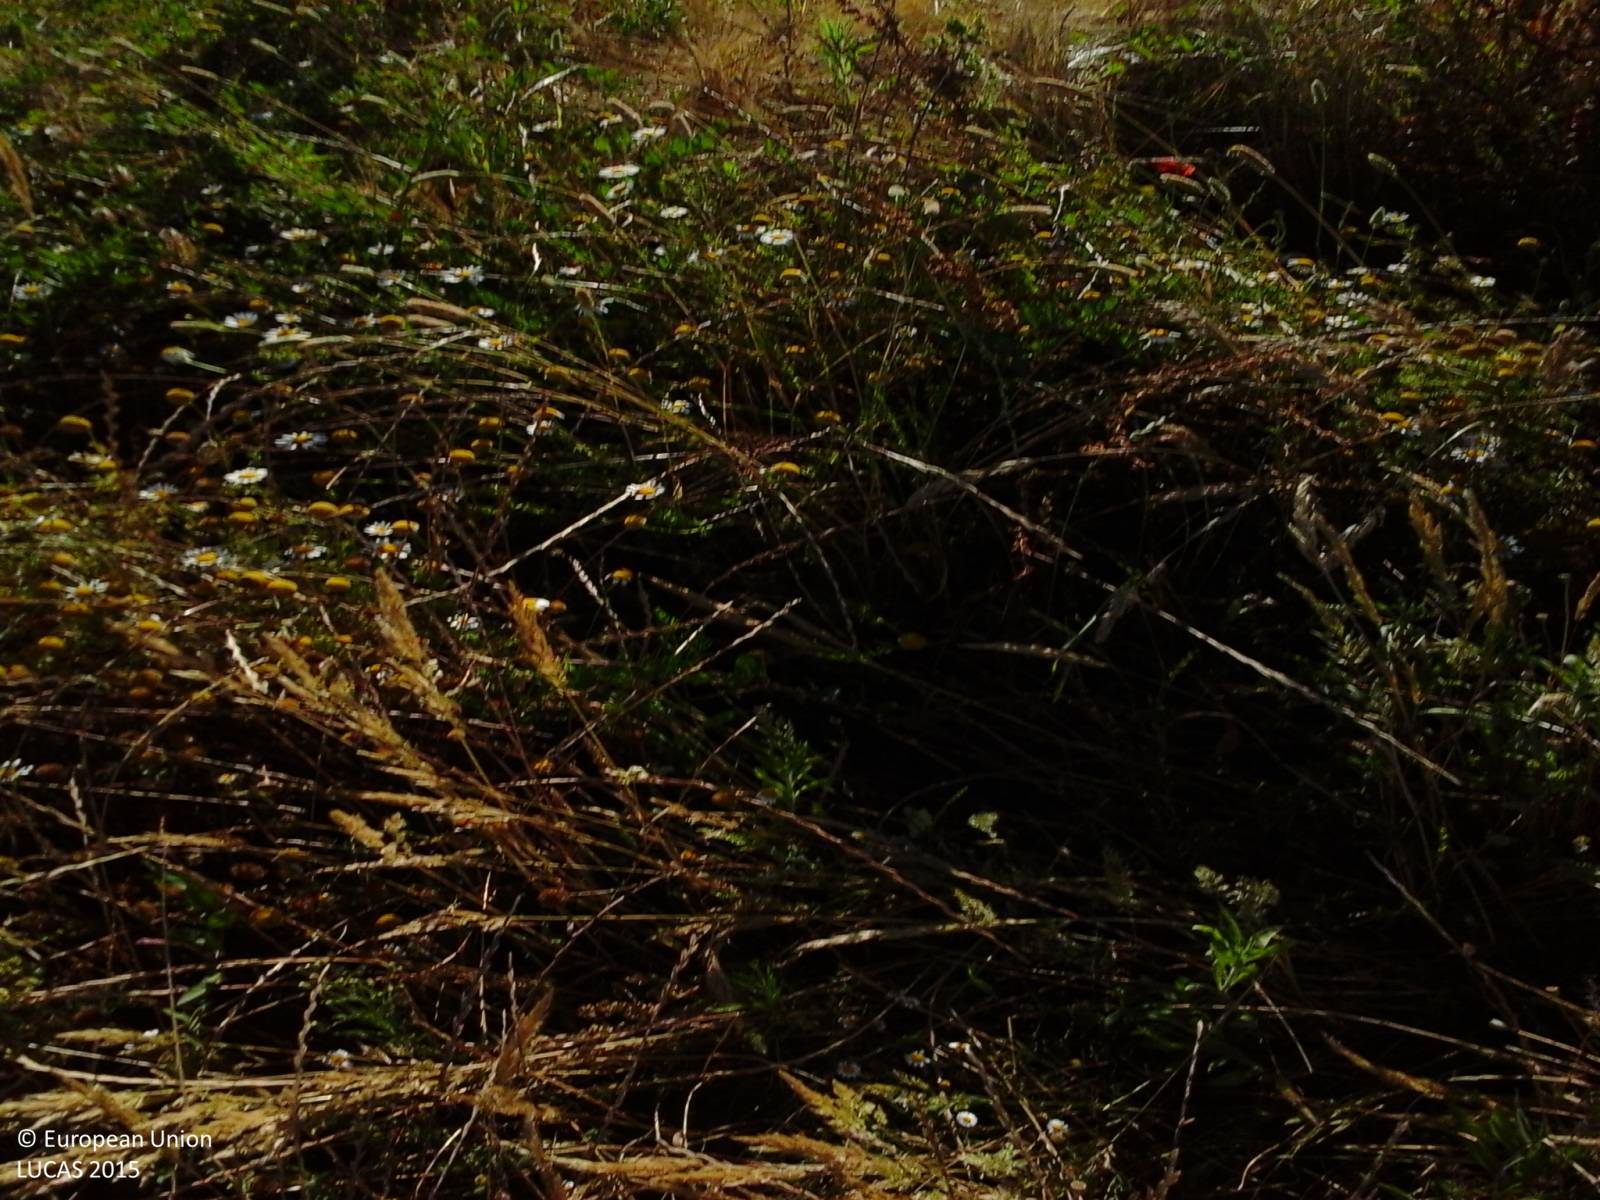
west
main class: Cropland
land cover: Barley
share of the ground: > 75 %
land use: Agriculture (excluding fallow land and kitchen gardens)
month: June
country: IT
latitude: 42.4469
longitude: 12.3144
